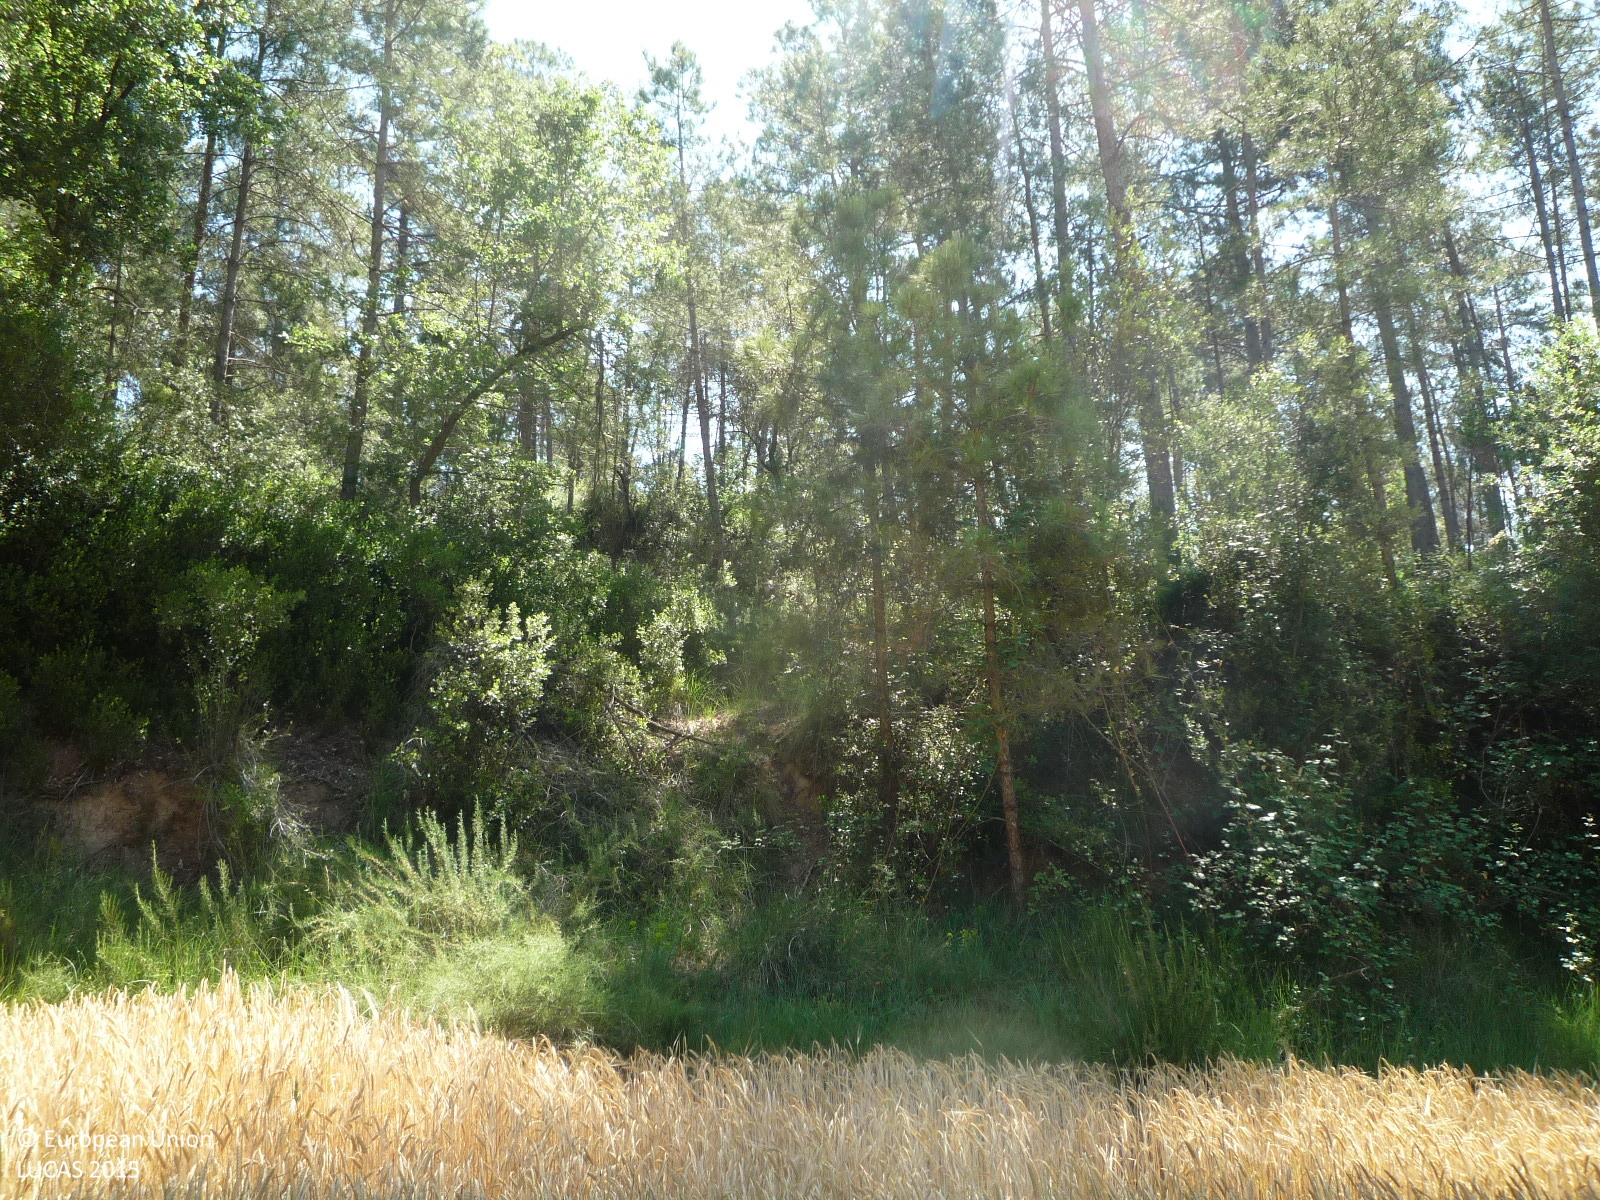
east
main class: Cropland
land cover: Barley
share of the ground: > 75 %
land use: Agriculture (excluding fallow land and kitchen gardens)
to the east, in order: Barley; Pine dominated mixed woodland; Rock outcrops; Pine dominated mixed woodland; Tracks; Pine dominated mixed woodland
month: May
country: ES
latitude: 41.9356
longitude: 1.9698
